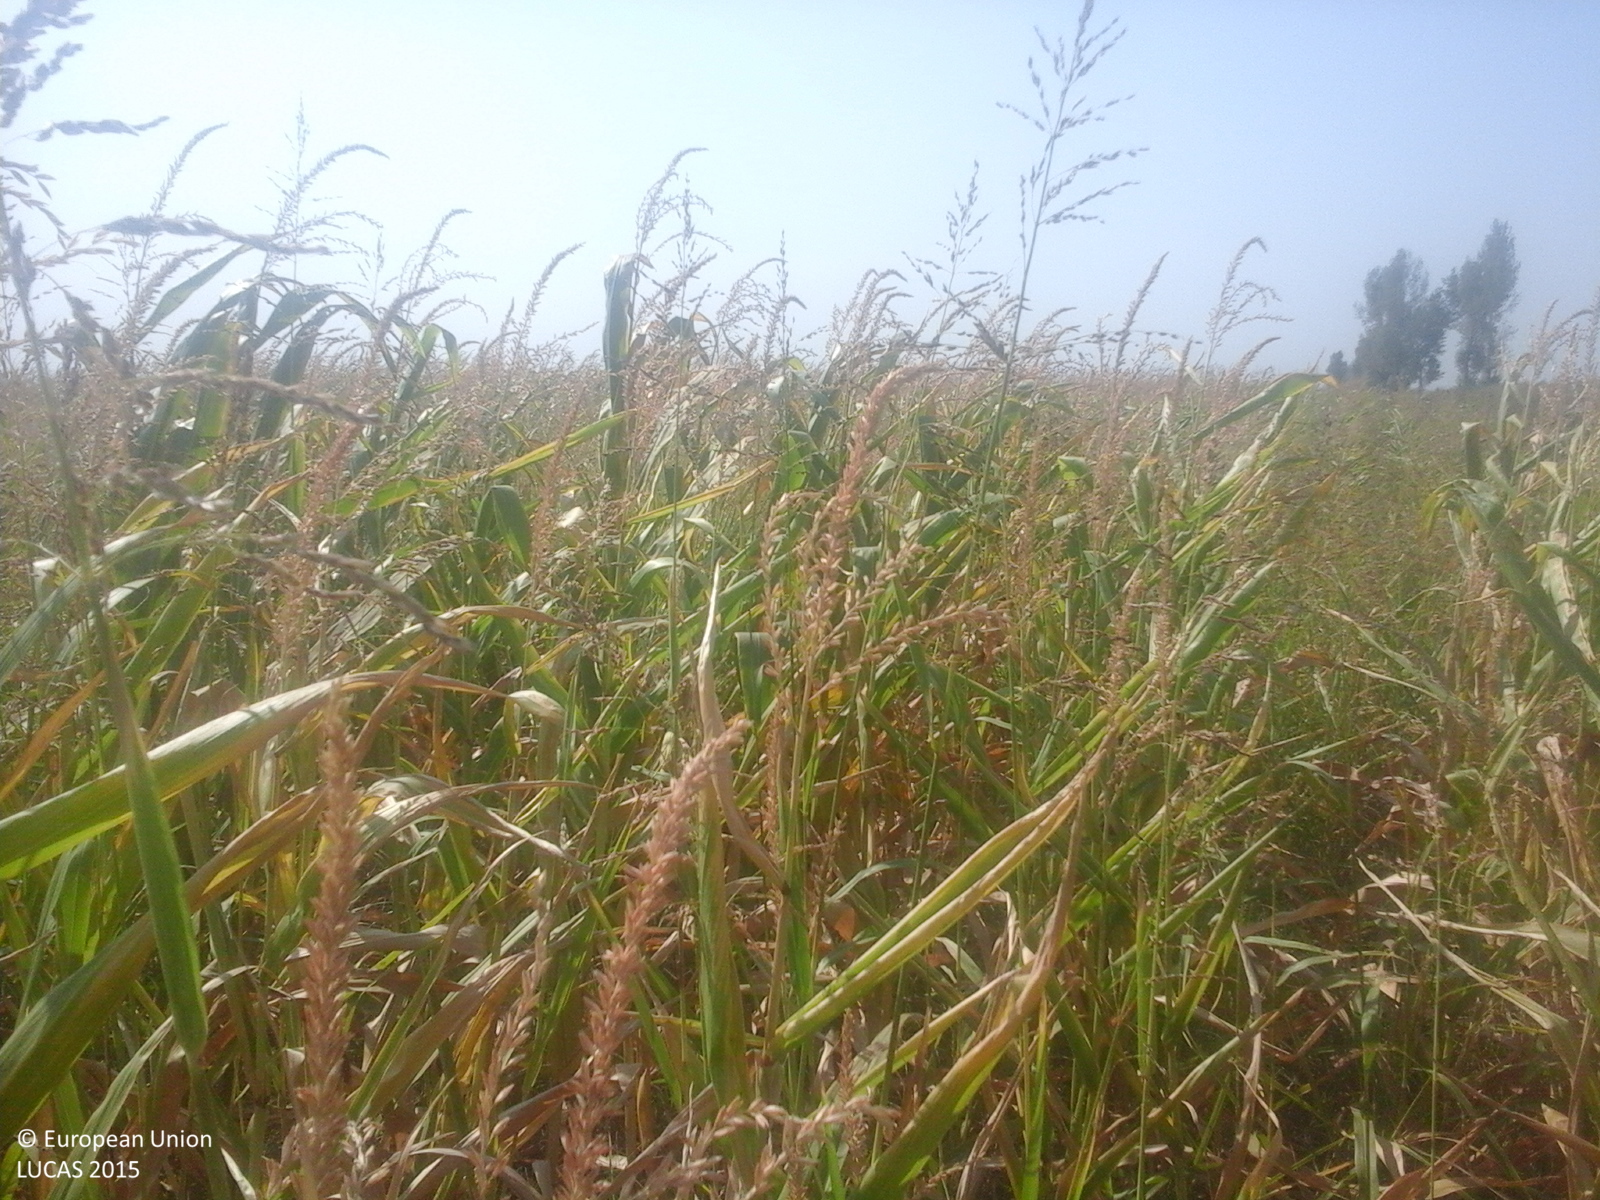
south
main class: Cropland
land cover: Maize
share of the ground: > 75 %
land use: Agriculture (excluding fallow land and kitchen gardens)
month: August
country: RO
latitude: 45.0974
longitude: 27.4949
